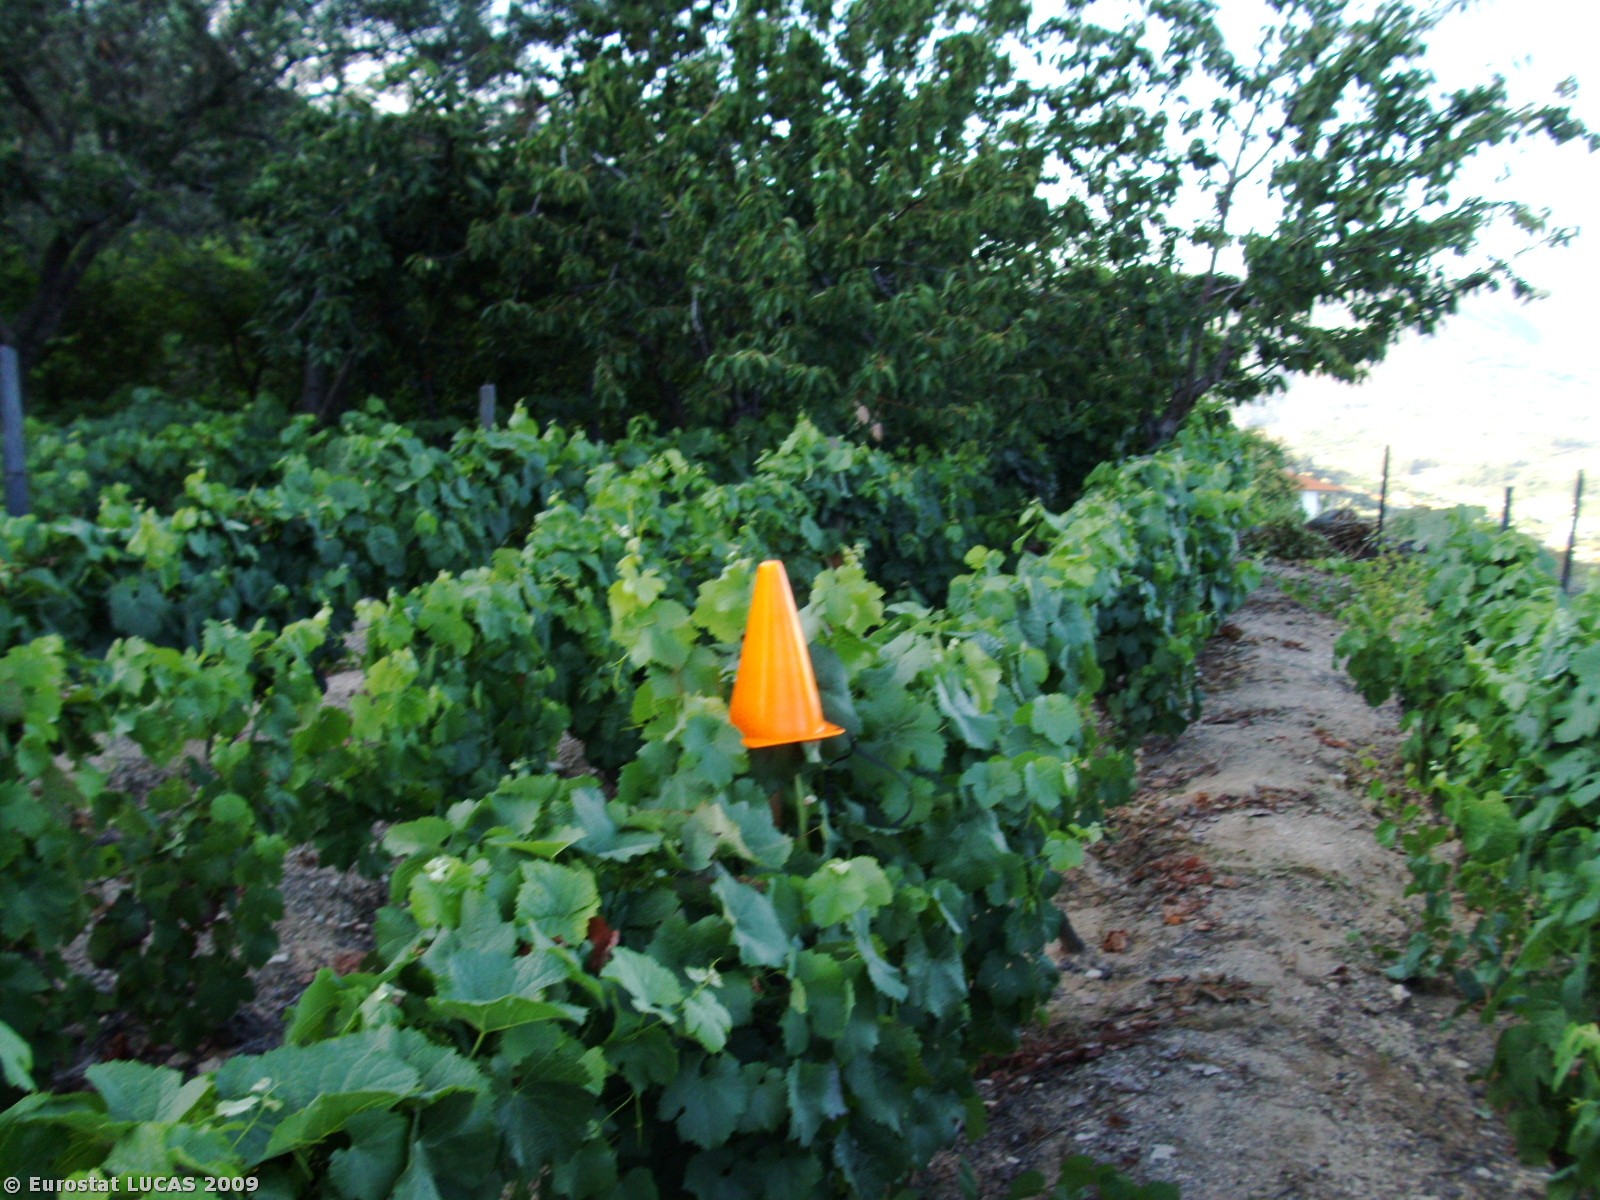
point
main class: Cropland
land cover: Vineyards
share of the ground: 25 - 50 %
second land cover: Bare land
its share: > 75 %
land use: Agriculture (excluding fallow land and kitchen gardens)
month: July
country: PT
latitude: 41.0449
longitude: -7.7941
